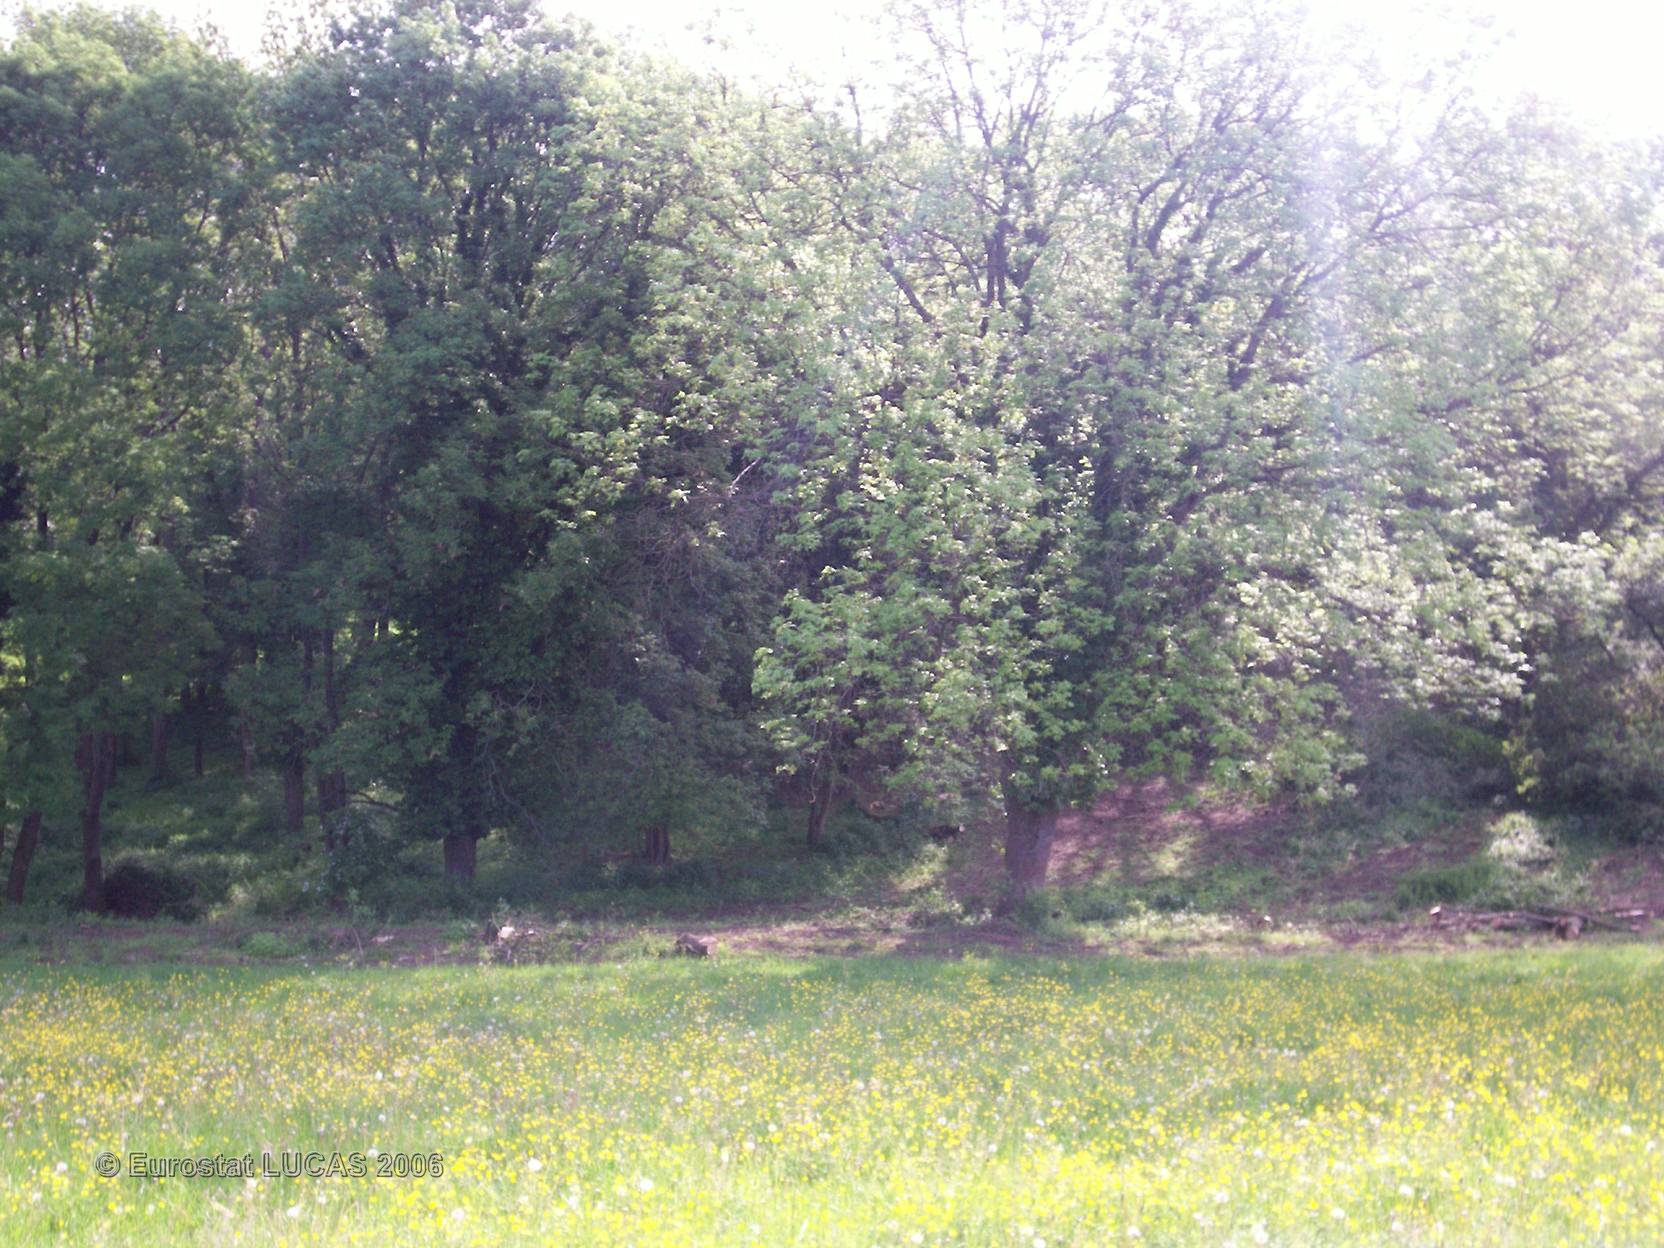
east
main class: Grassland
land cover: Grassland without tree/shrub cover
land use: Agriculture (excluding fallow land and kitchen gardens)
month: May
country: FR
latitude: 45.8618
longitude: 4.7609
